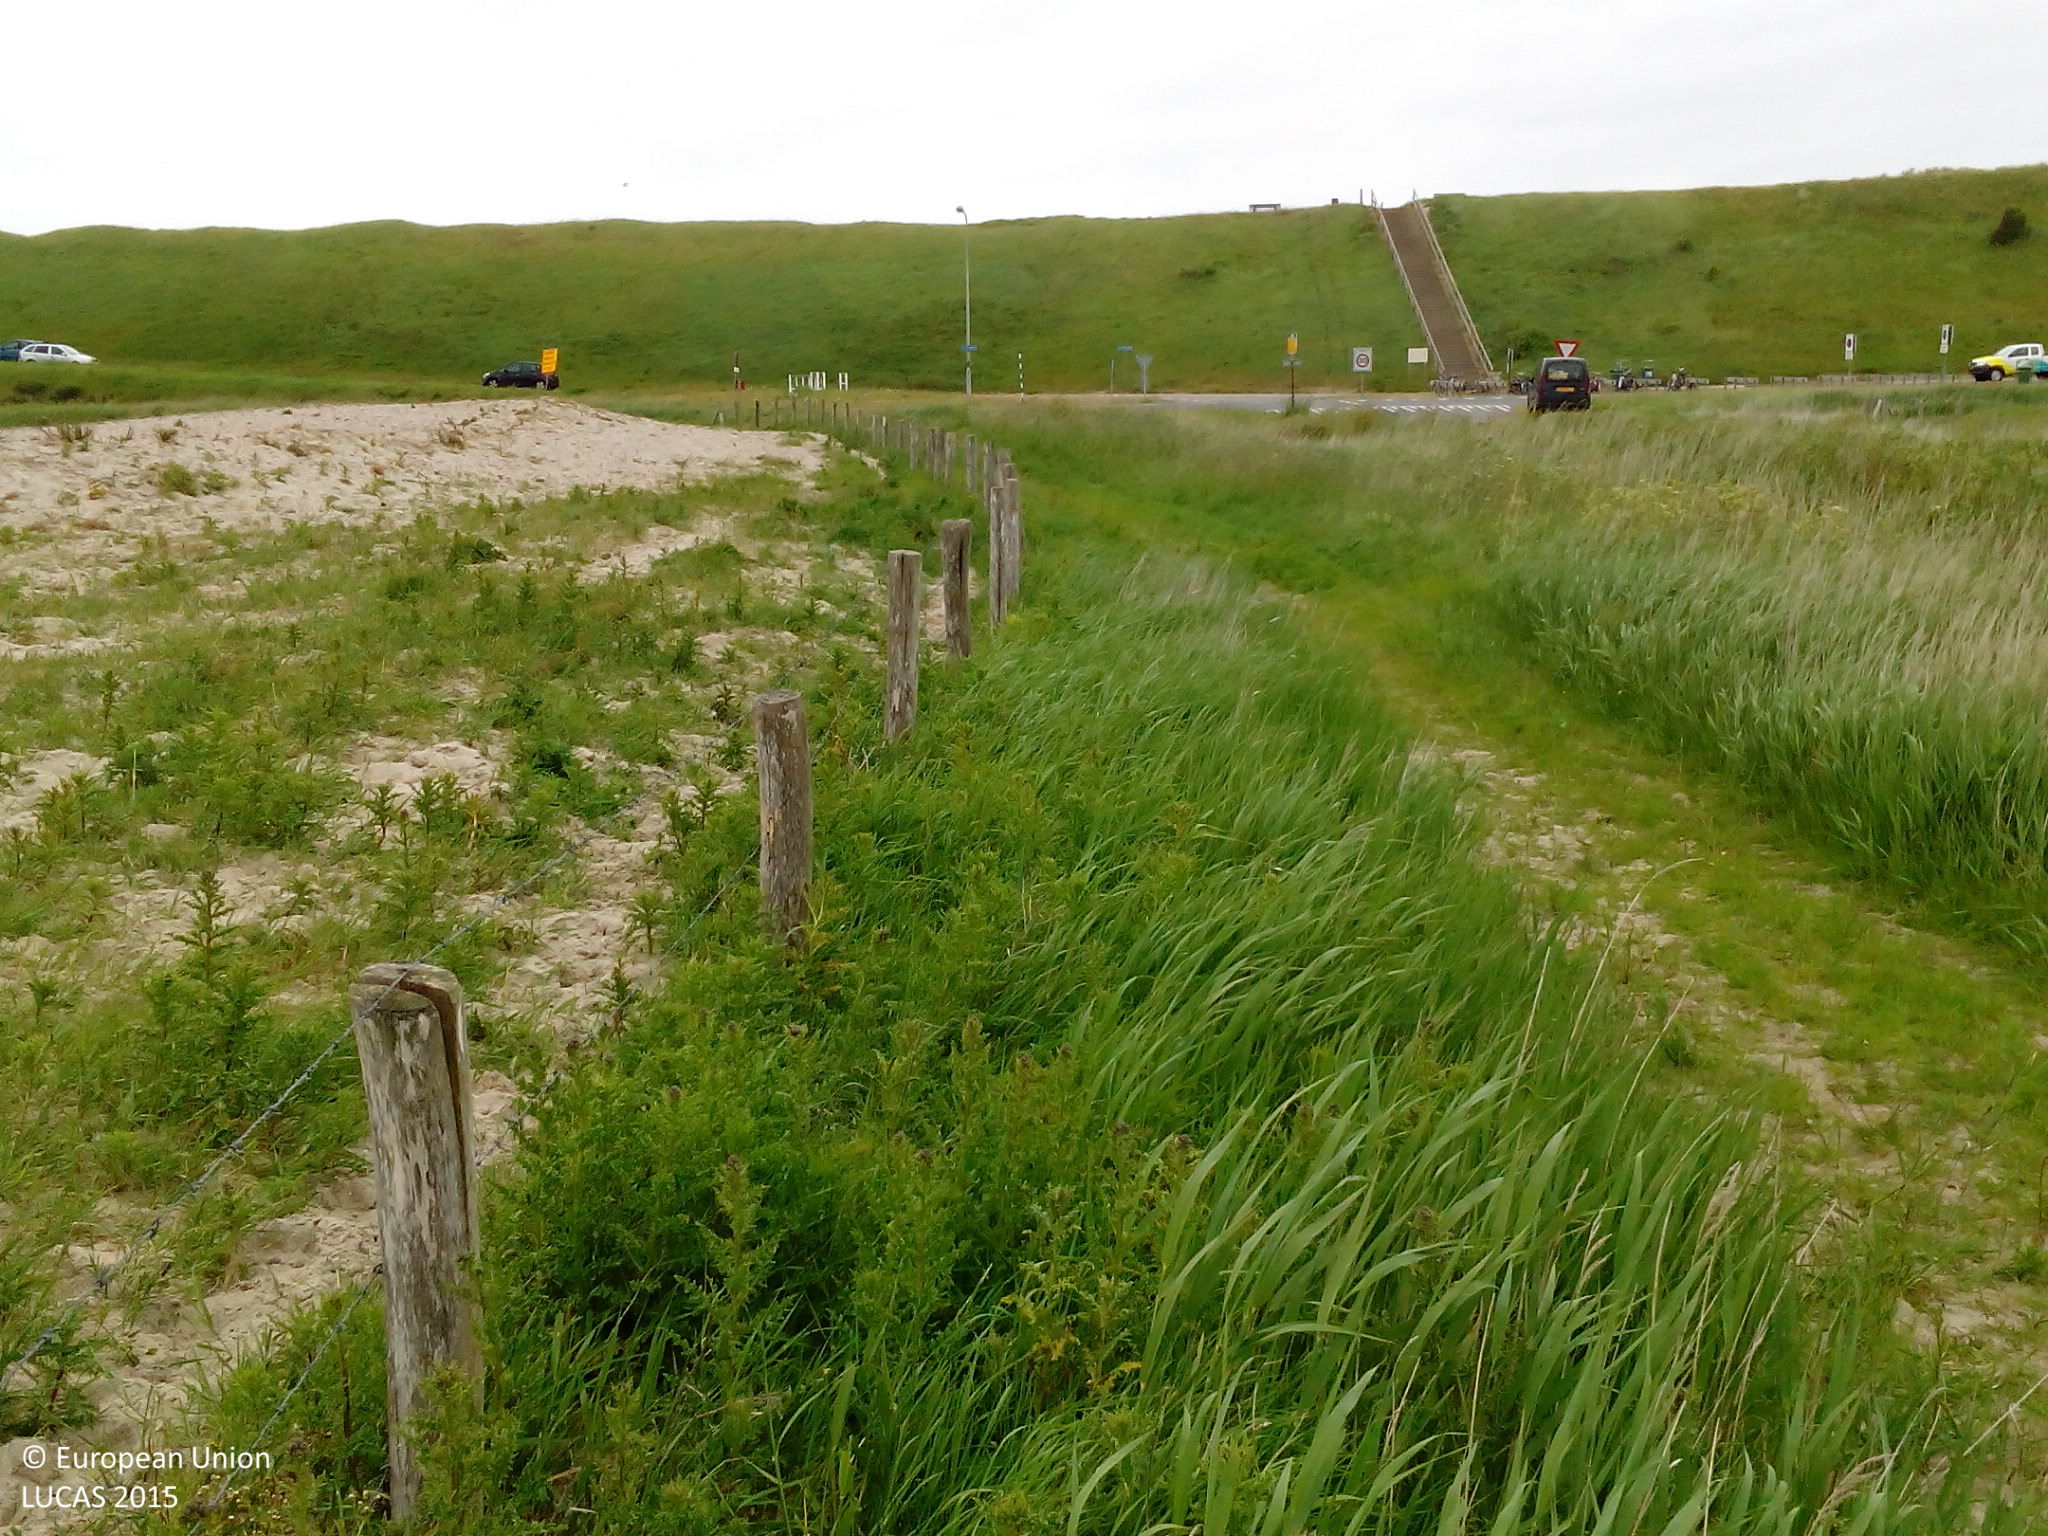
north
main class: Grassland
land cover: Grassland without tree/shrub cover
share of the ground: > 75 %
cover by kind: herbaceous plants 80 %, unconsolidated bare surface 20 %
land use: Semi-natural and natural areas not in use
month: June
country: NL
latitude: 51.5478
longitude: 3.4595
